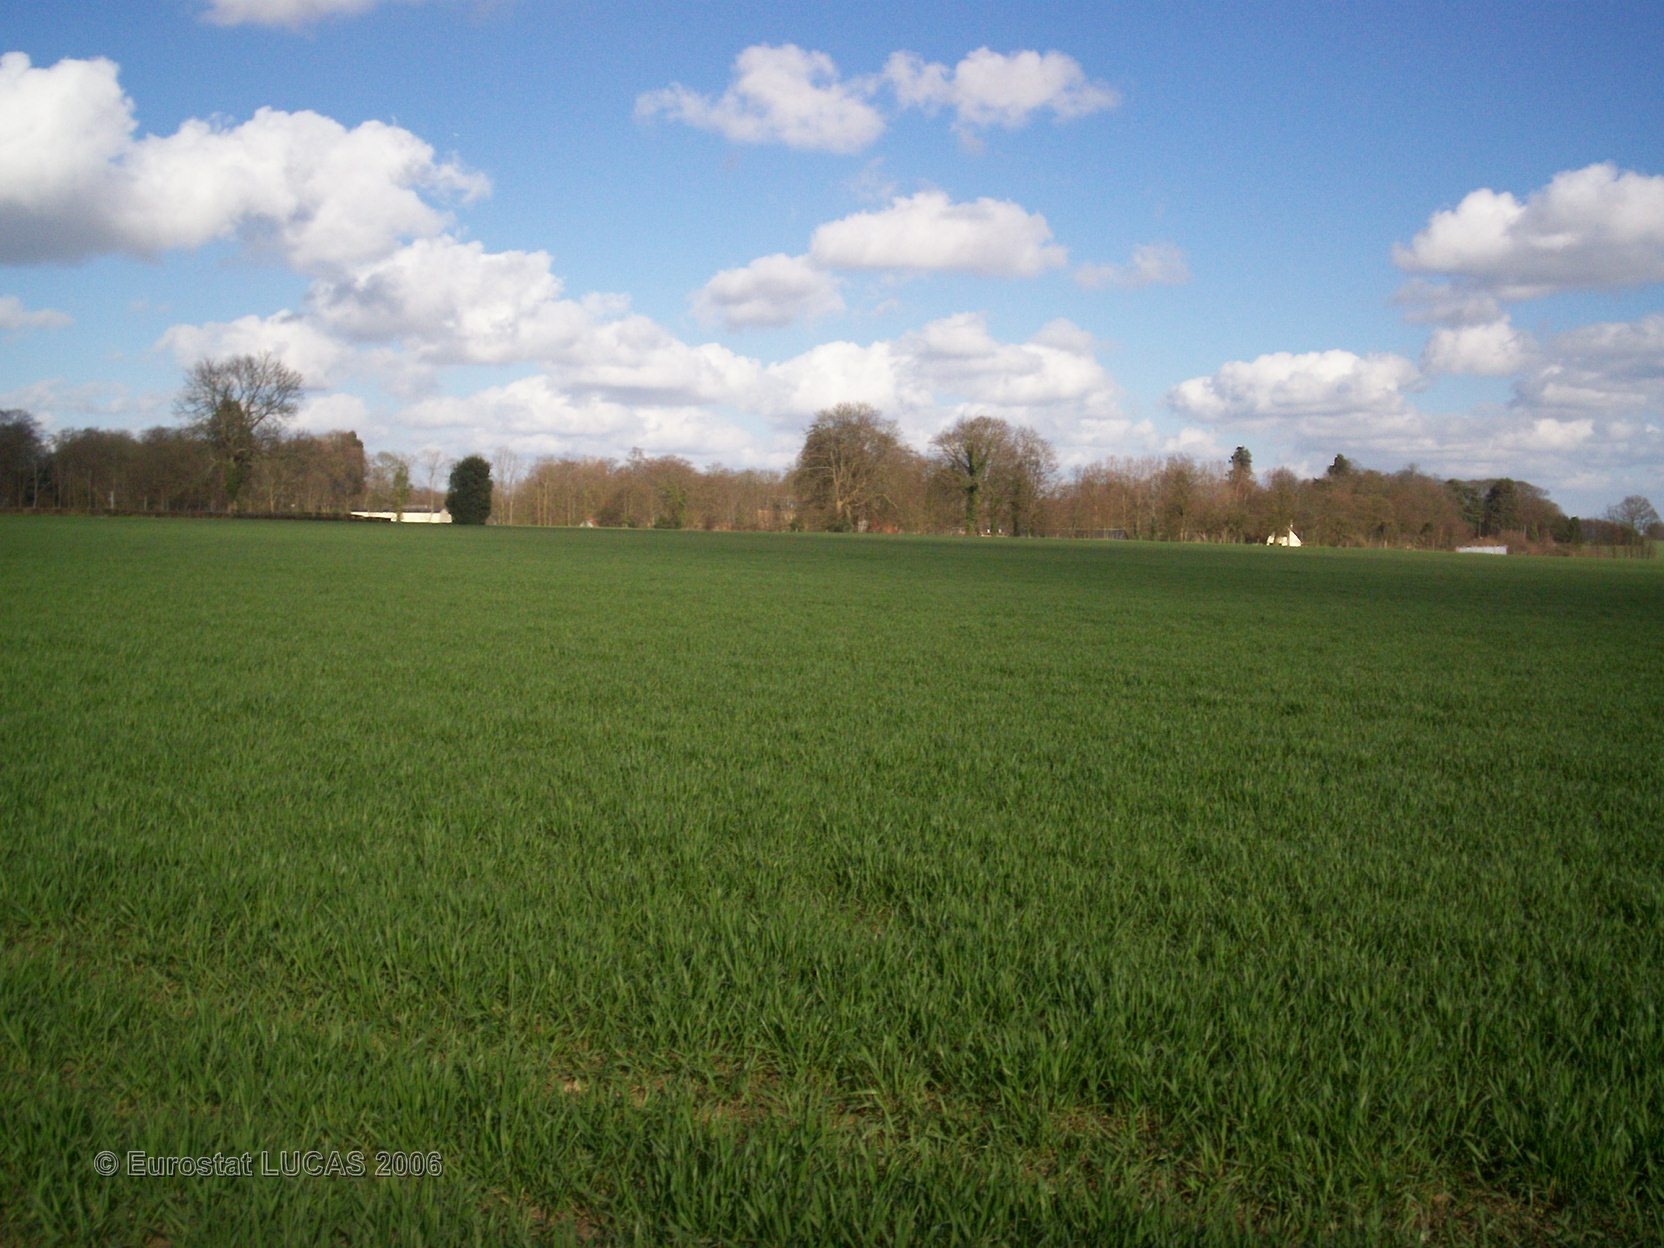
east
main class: Cropland
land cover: Common wheat
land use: Agriculture (excluding fallow land and kitchen gardens)
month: April
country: FR
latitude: 49.6058
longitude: 0.9409
